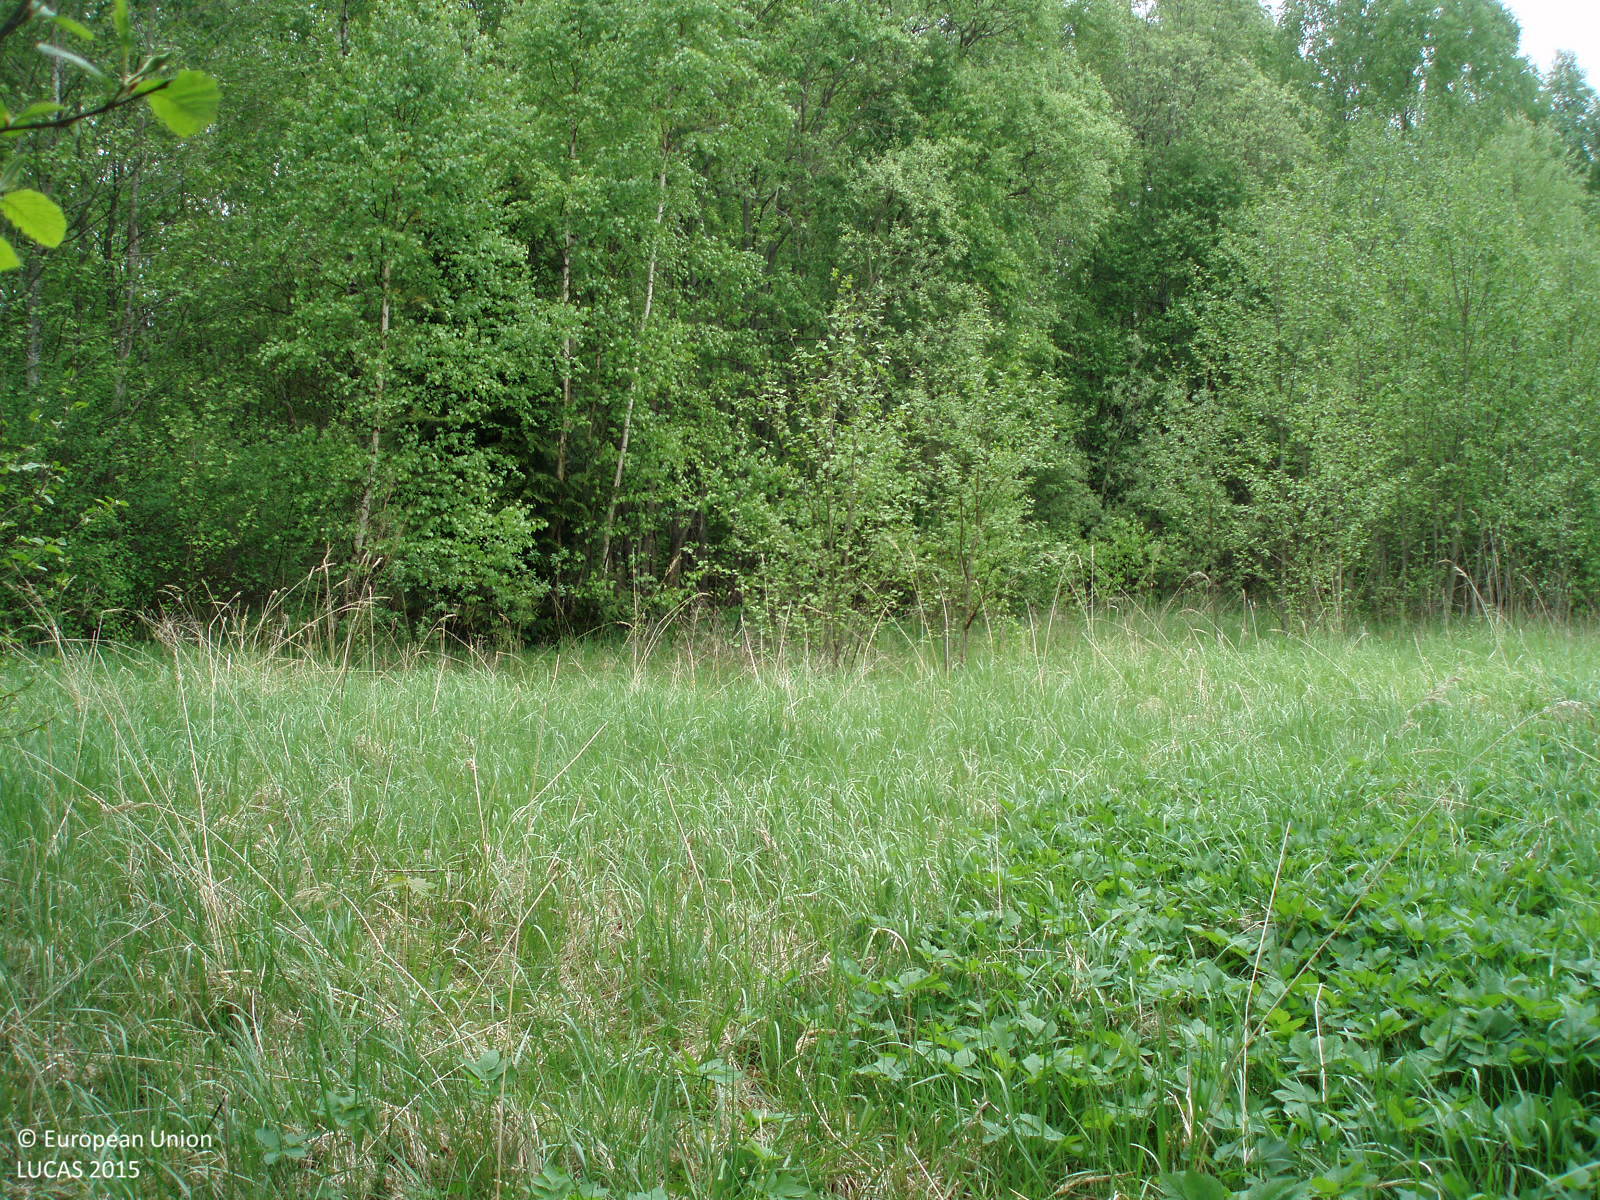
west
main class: Grassland
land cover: Spontaneously vegetated surfaces
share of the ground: > 75 %
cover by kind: herbaceous plants 100 %
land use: Semi-natural and natural areas not in use
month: May
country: LT
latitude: 56.3275
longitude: 22.4283
